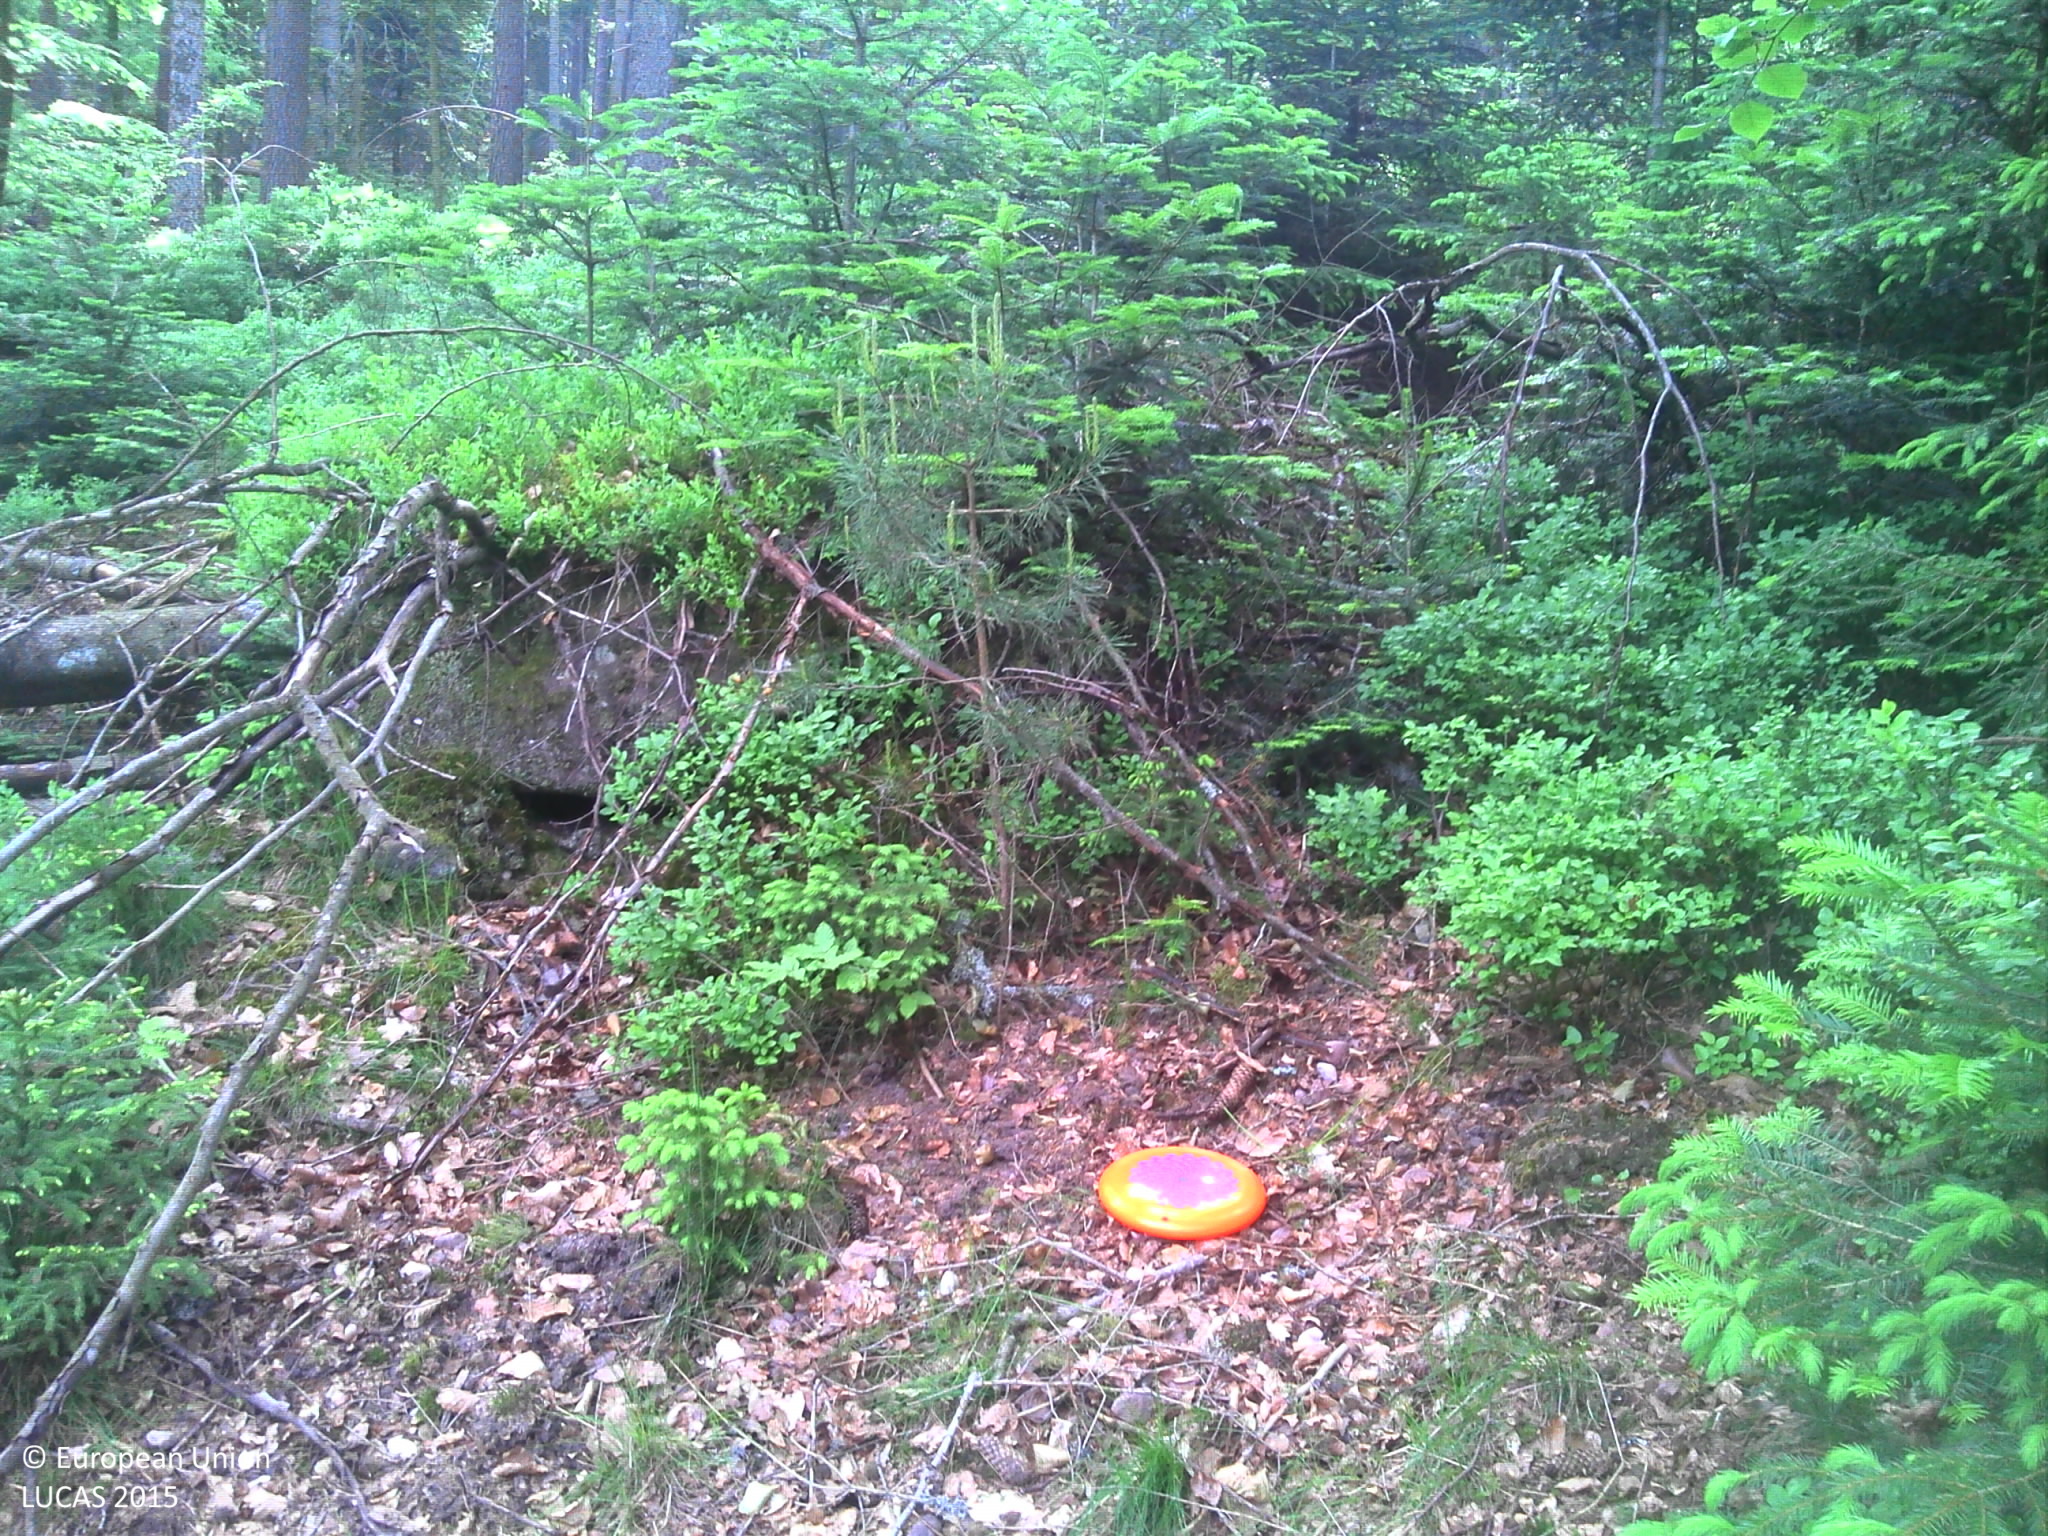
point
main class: Woodland
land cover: Spruce dominated mixed woodland
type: mountainous beech forest
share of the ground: > 75 %
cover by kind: coniferous forest trees 70 %, broadleaved forest trees 30 %
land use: Forestry
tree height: > 5 m
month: May
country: FR
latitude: 48.2983
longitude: 7.2914
